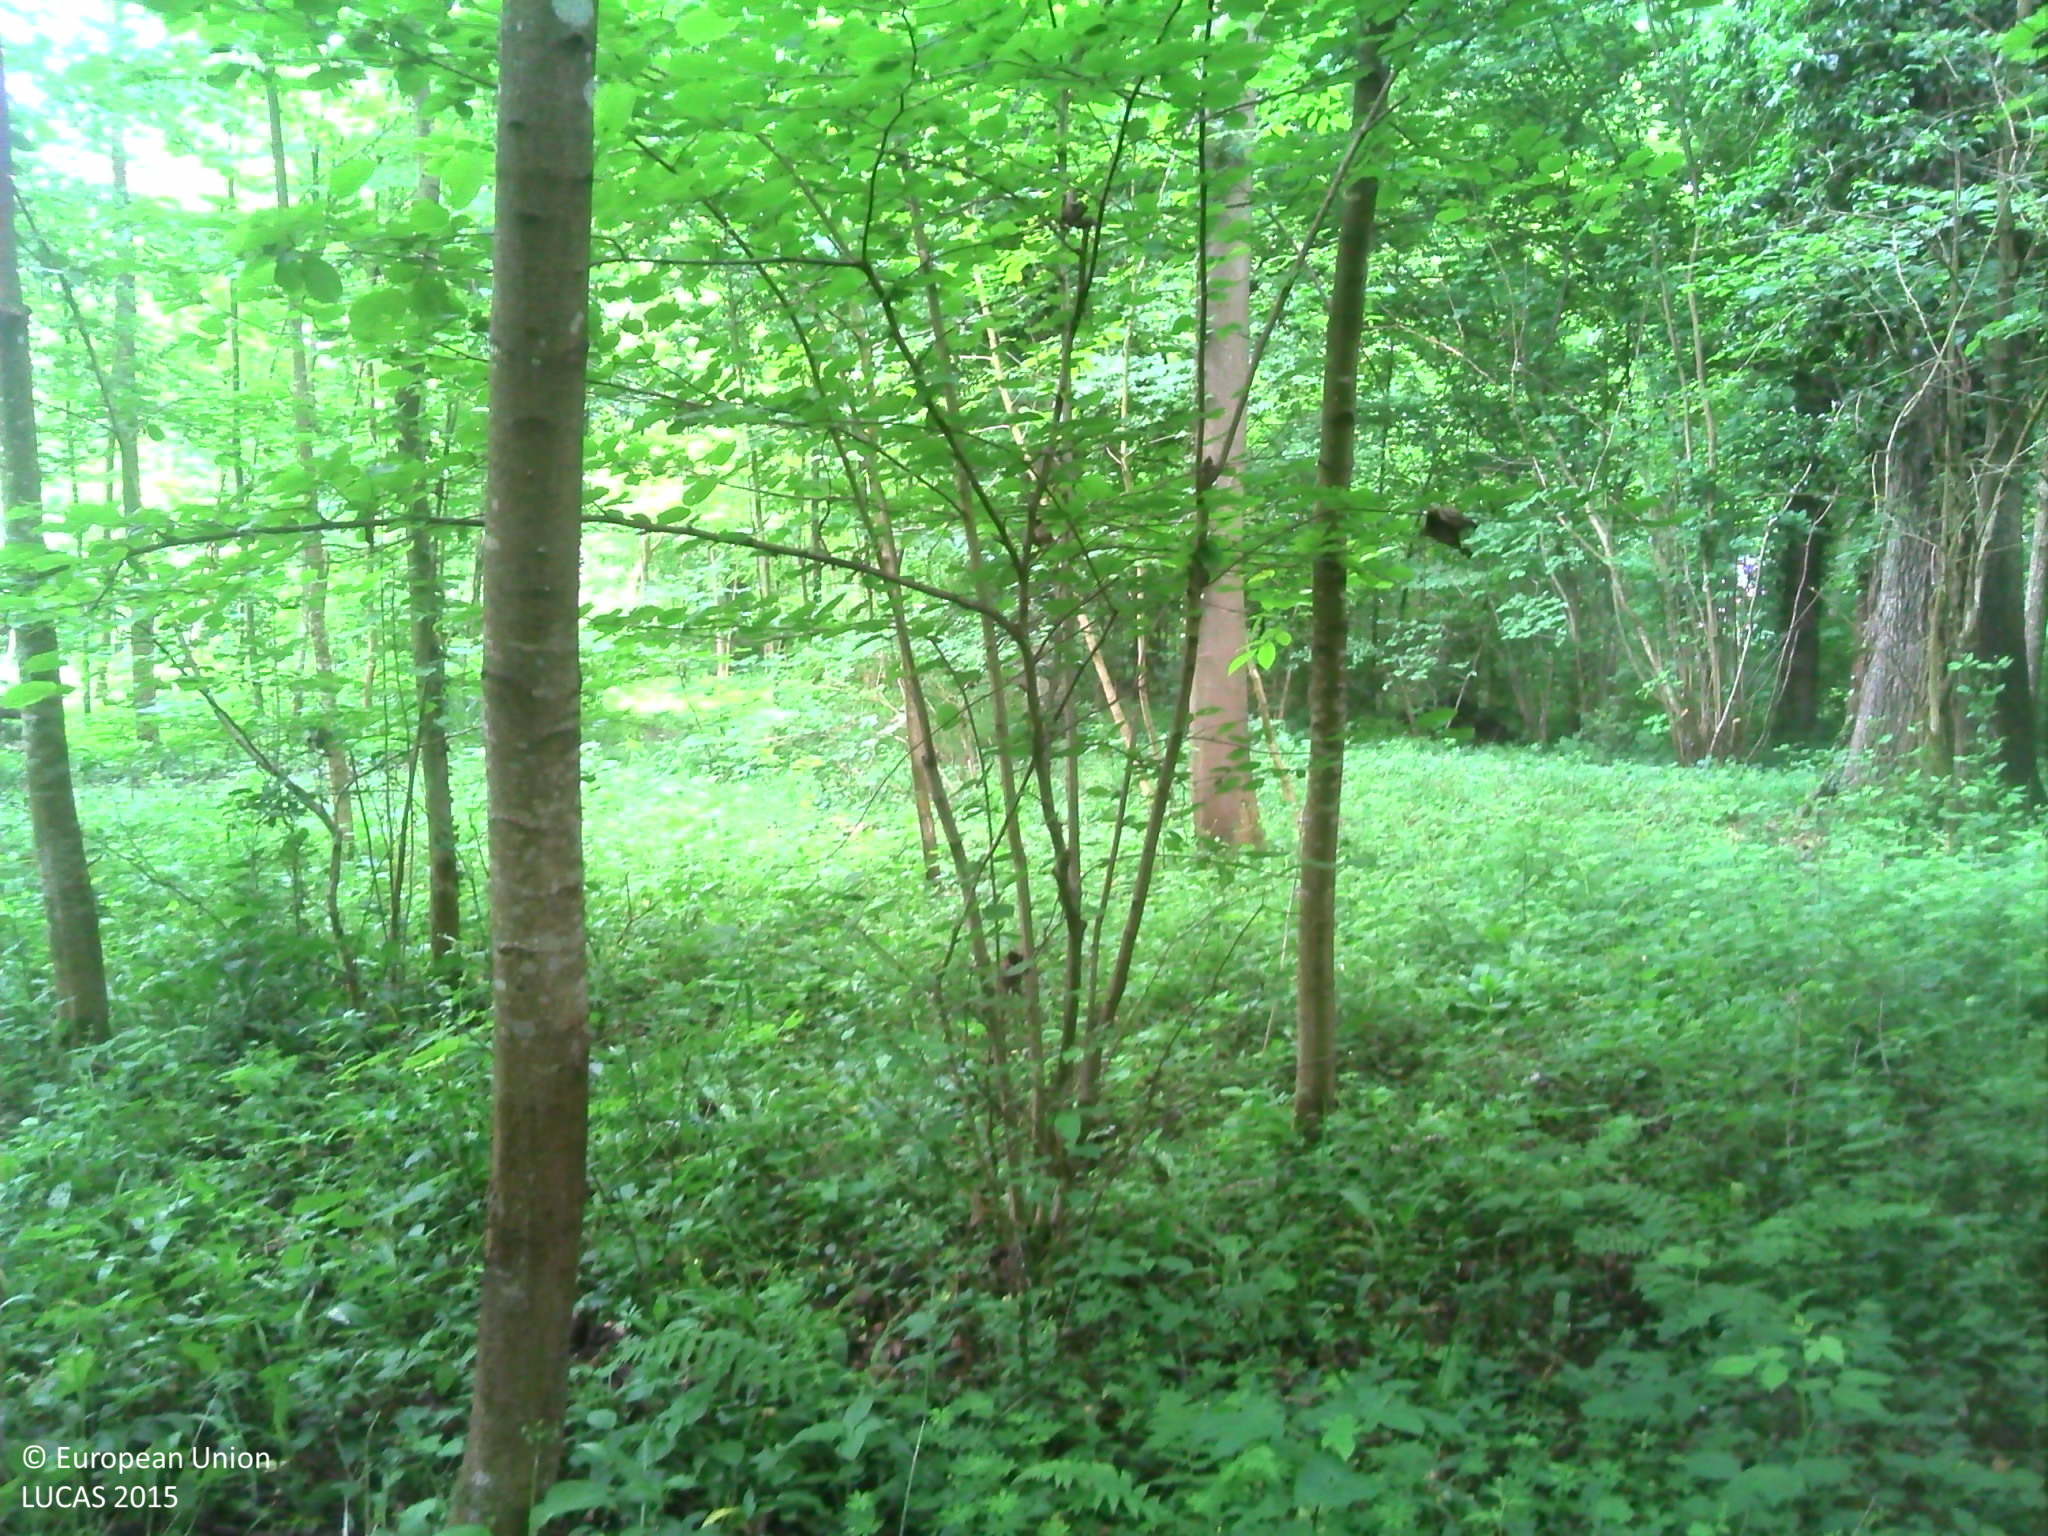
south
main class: Woodland
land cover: Broadleaved woodland
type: mesophytic deciduous forest
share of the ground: > 75 %
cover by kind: broadleaved forest trees 90 %, herbaceous plants 10 %
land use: Forestry
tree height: > 5 m
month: May
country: FR
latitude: 48.3064
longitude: 7.6416
